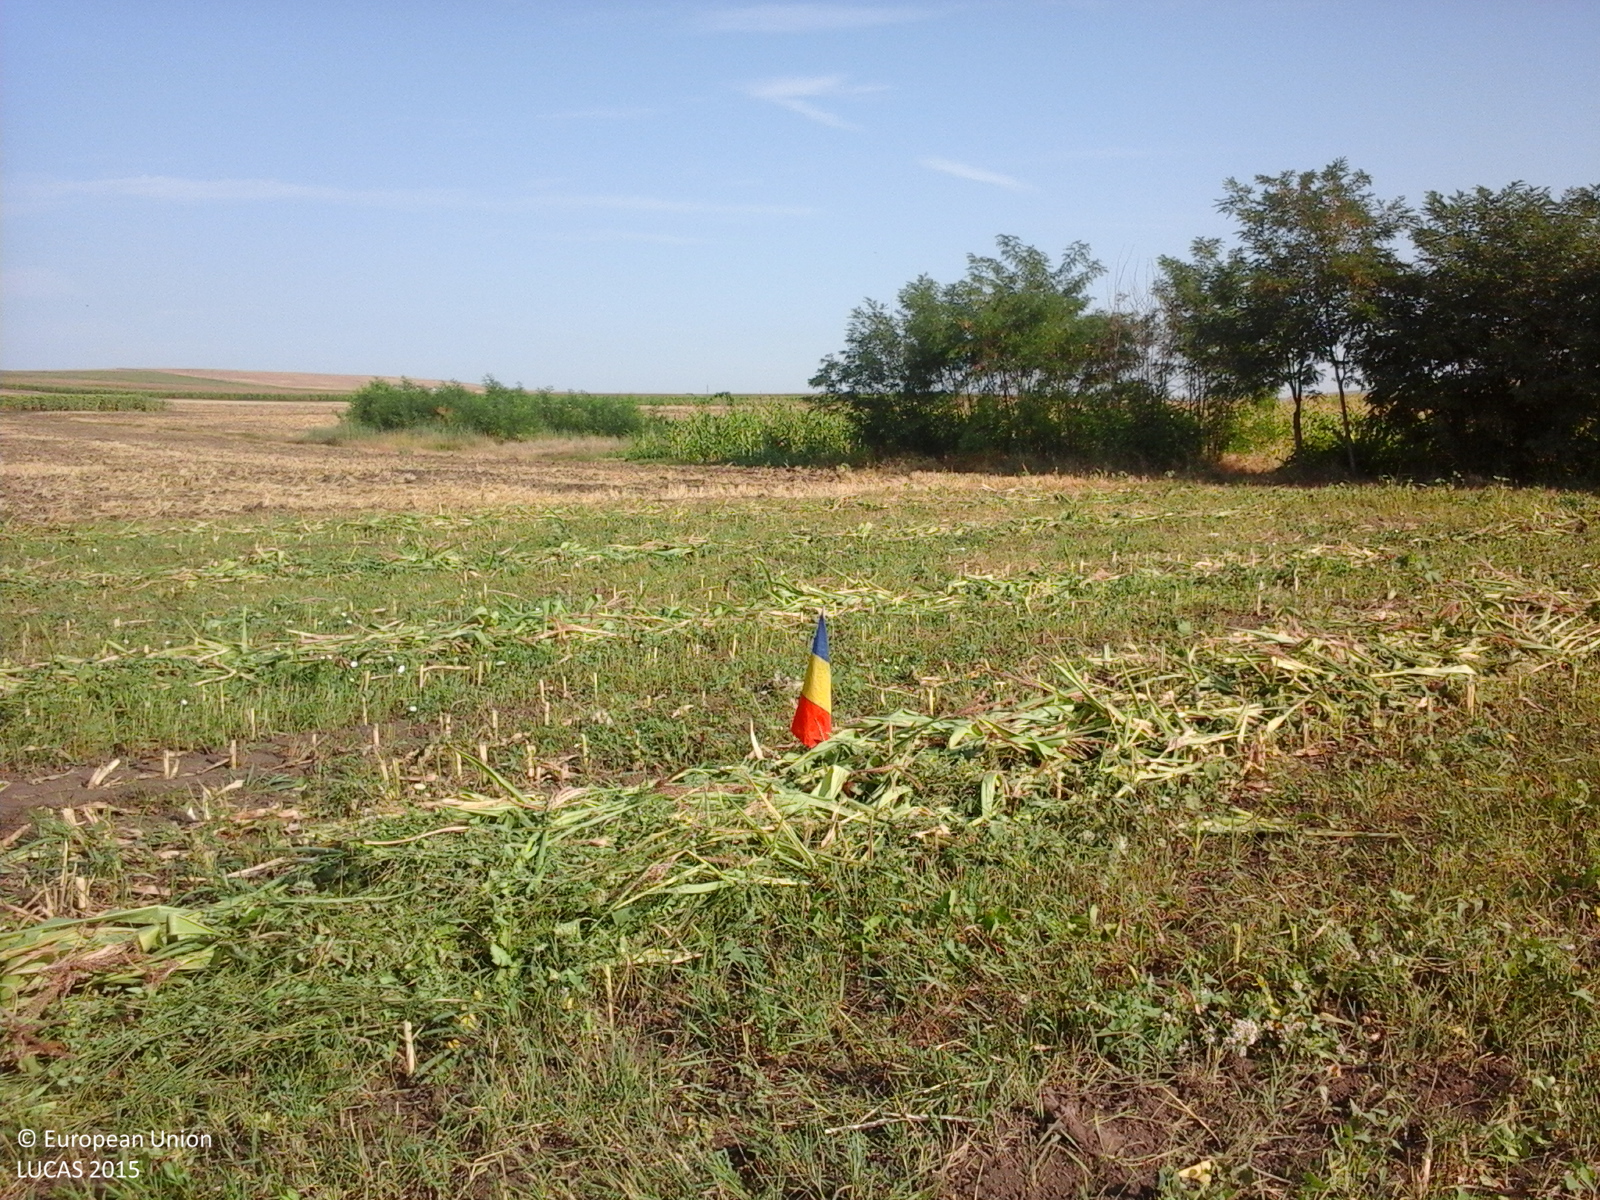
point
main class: Cropland
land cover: Maize
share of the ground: 25 - 50 %
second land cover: Spontaneously vegetated surfaces
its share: 50 - 75 %
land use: Agriculture (excluding fallow land and kitchen gardens)
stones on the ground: < 10 %
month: July
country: RO
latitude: 46.2660
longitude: 28.0976
